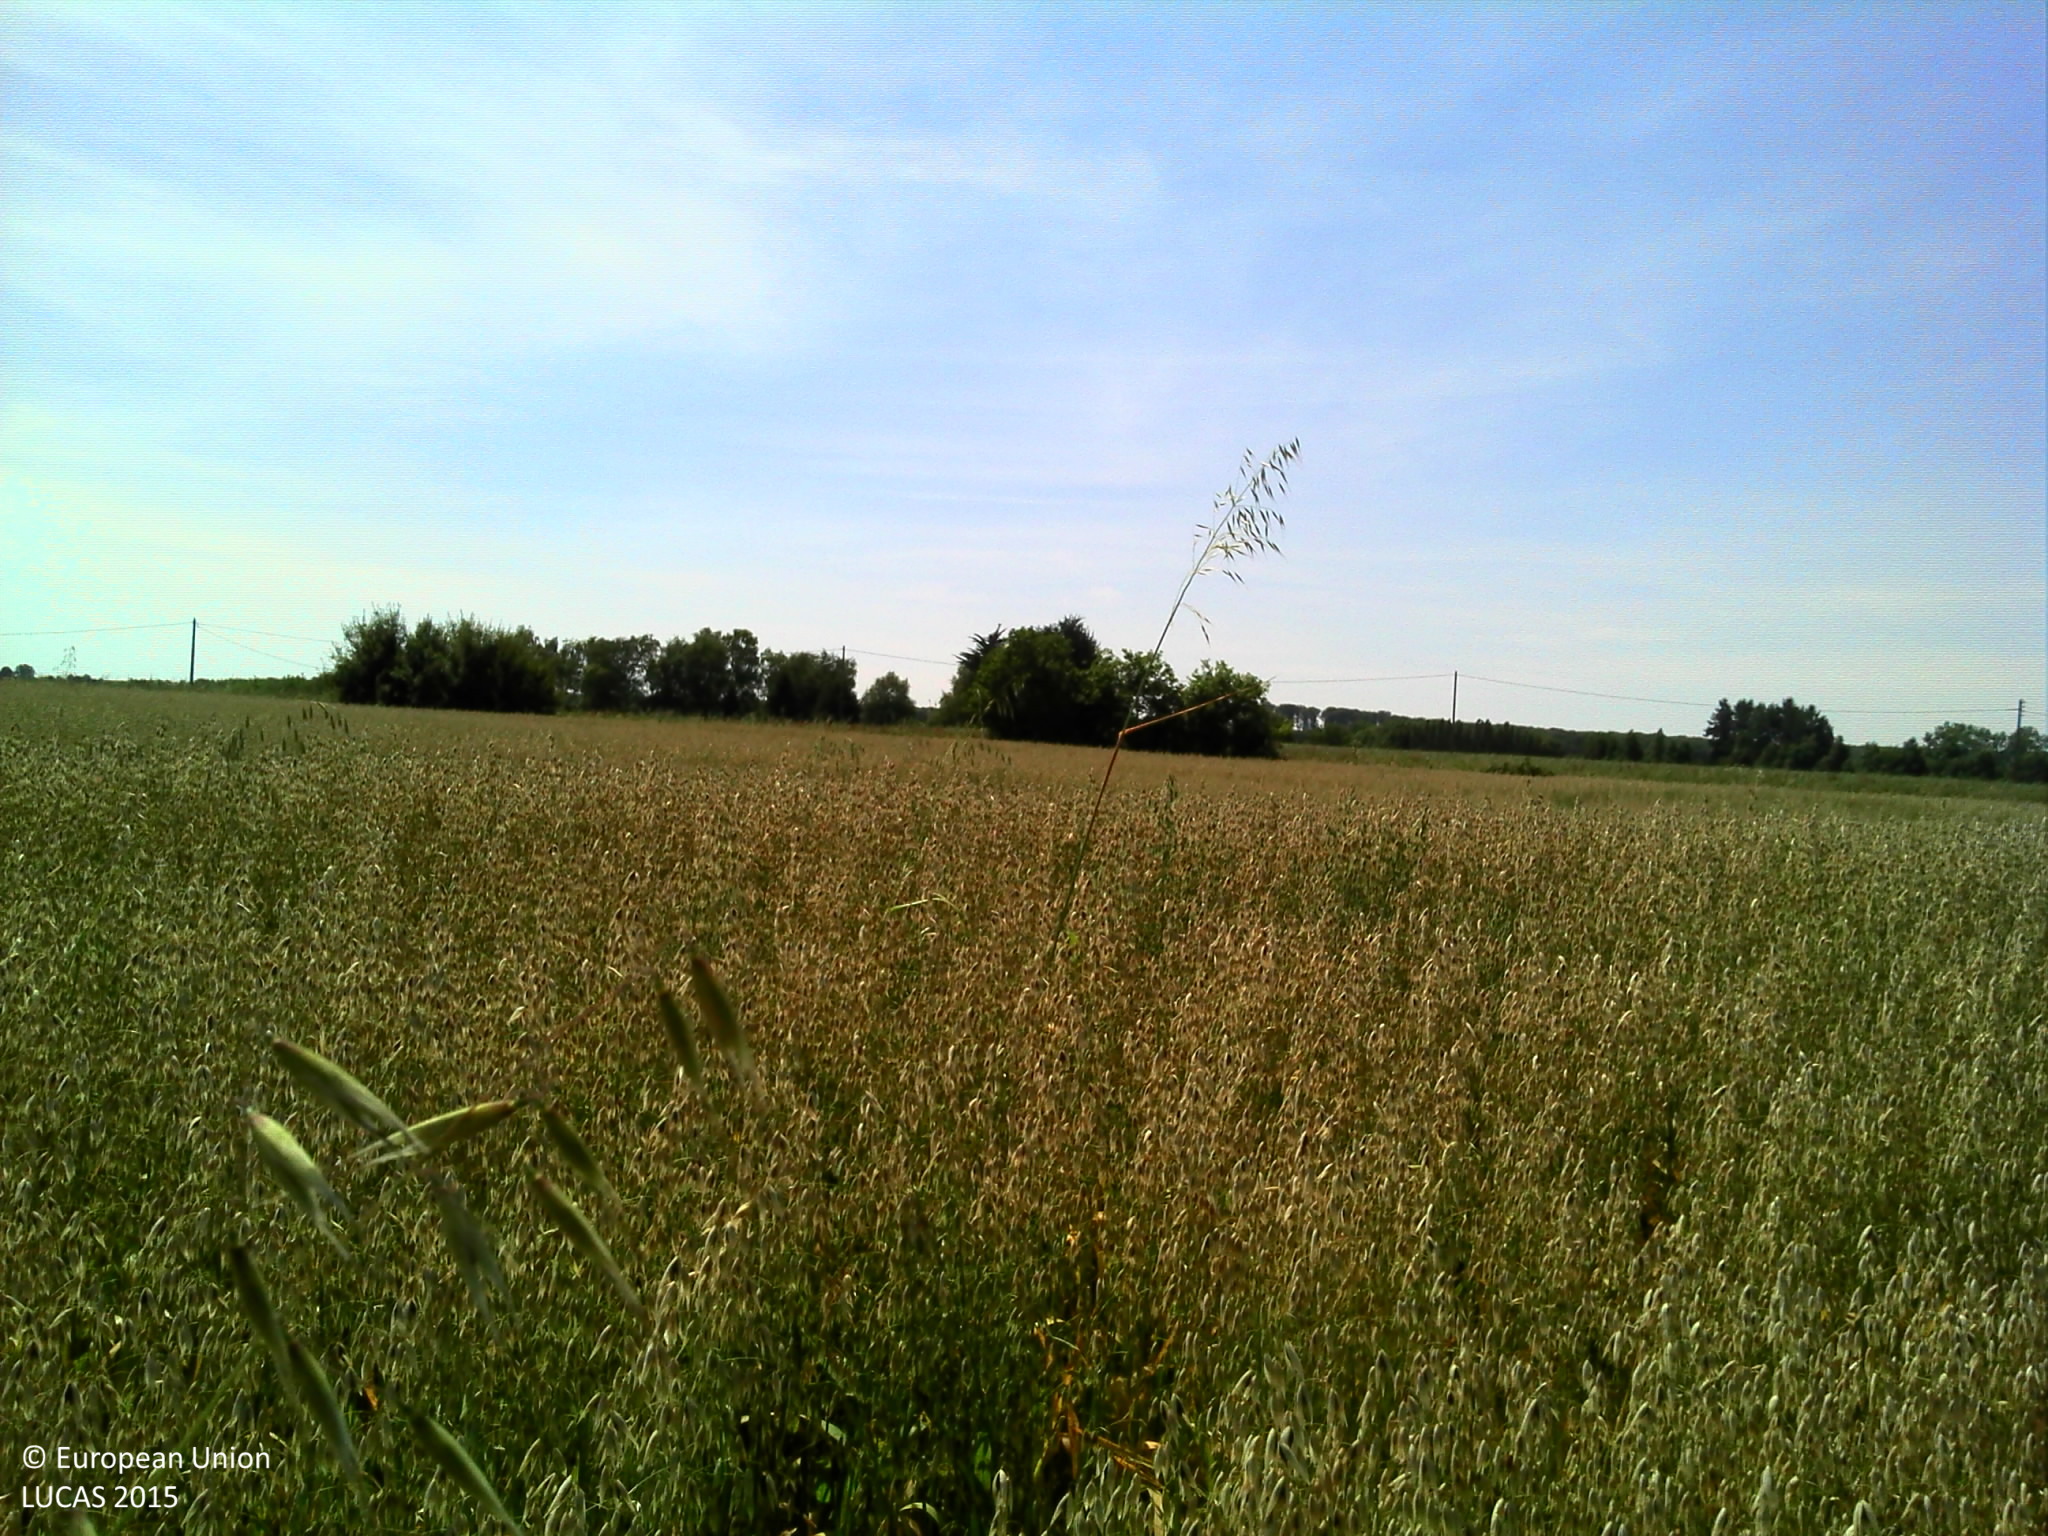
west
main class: Cropland
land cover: Oats
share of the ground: > 75 %
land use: Agriculture (excluding fallow land and kitchen gardens)
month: June
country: FR
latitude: 48.3695
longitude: 0.2403
